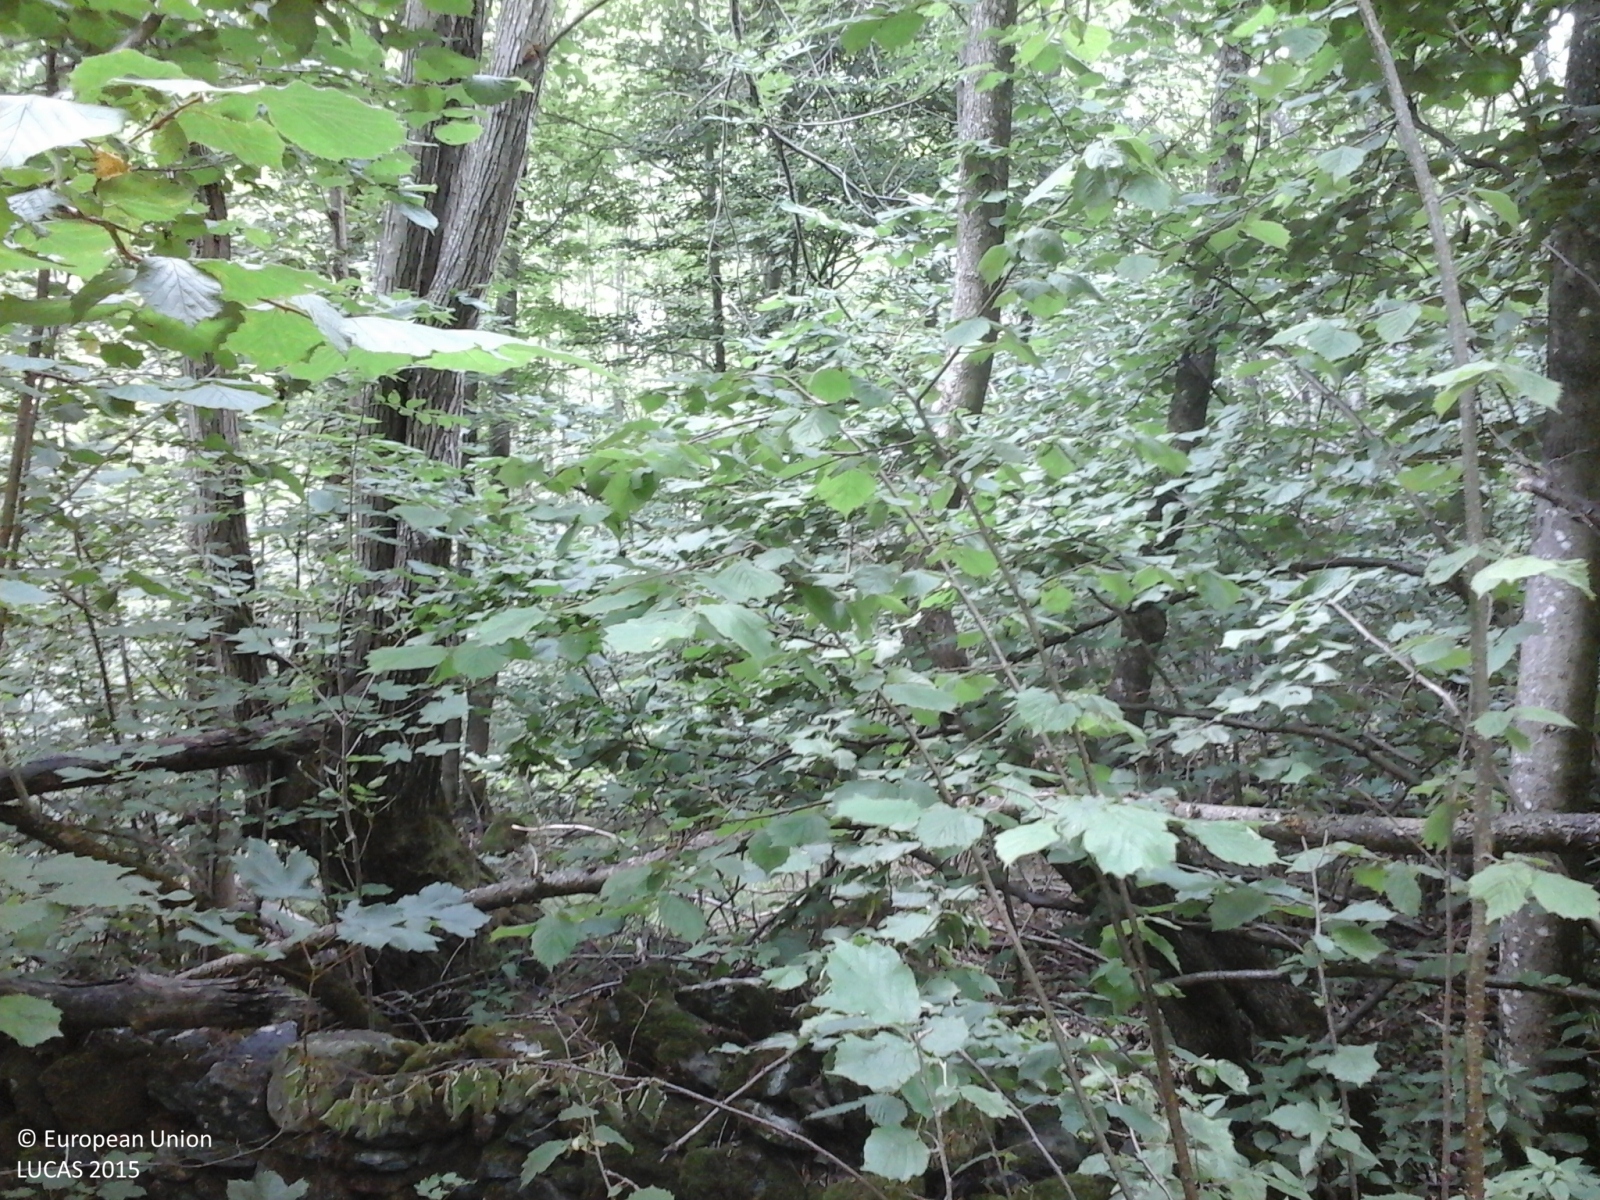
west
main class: Woodland
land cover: Broadleaved woodland
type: beech forest
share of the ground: > 75 %
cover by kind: broadleaved forest trees 100 %
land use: Forestry
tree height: > 5 m
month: July
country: IT
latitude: 45.2339
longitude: 7.2403
